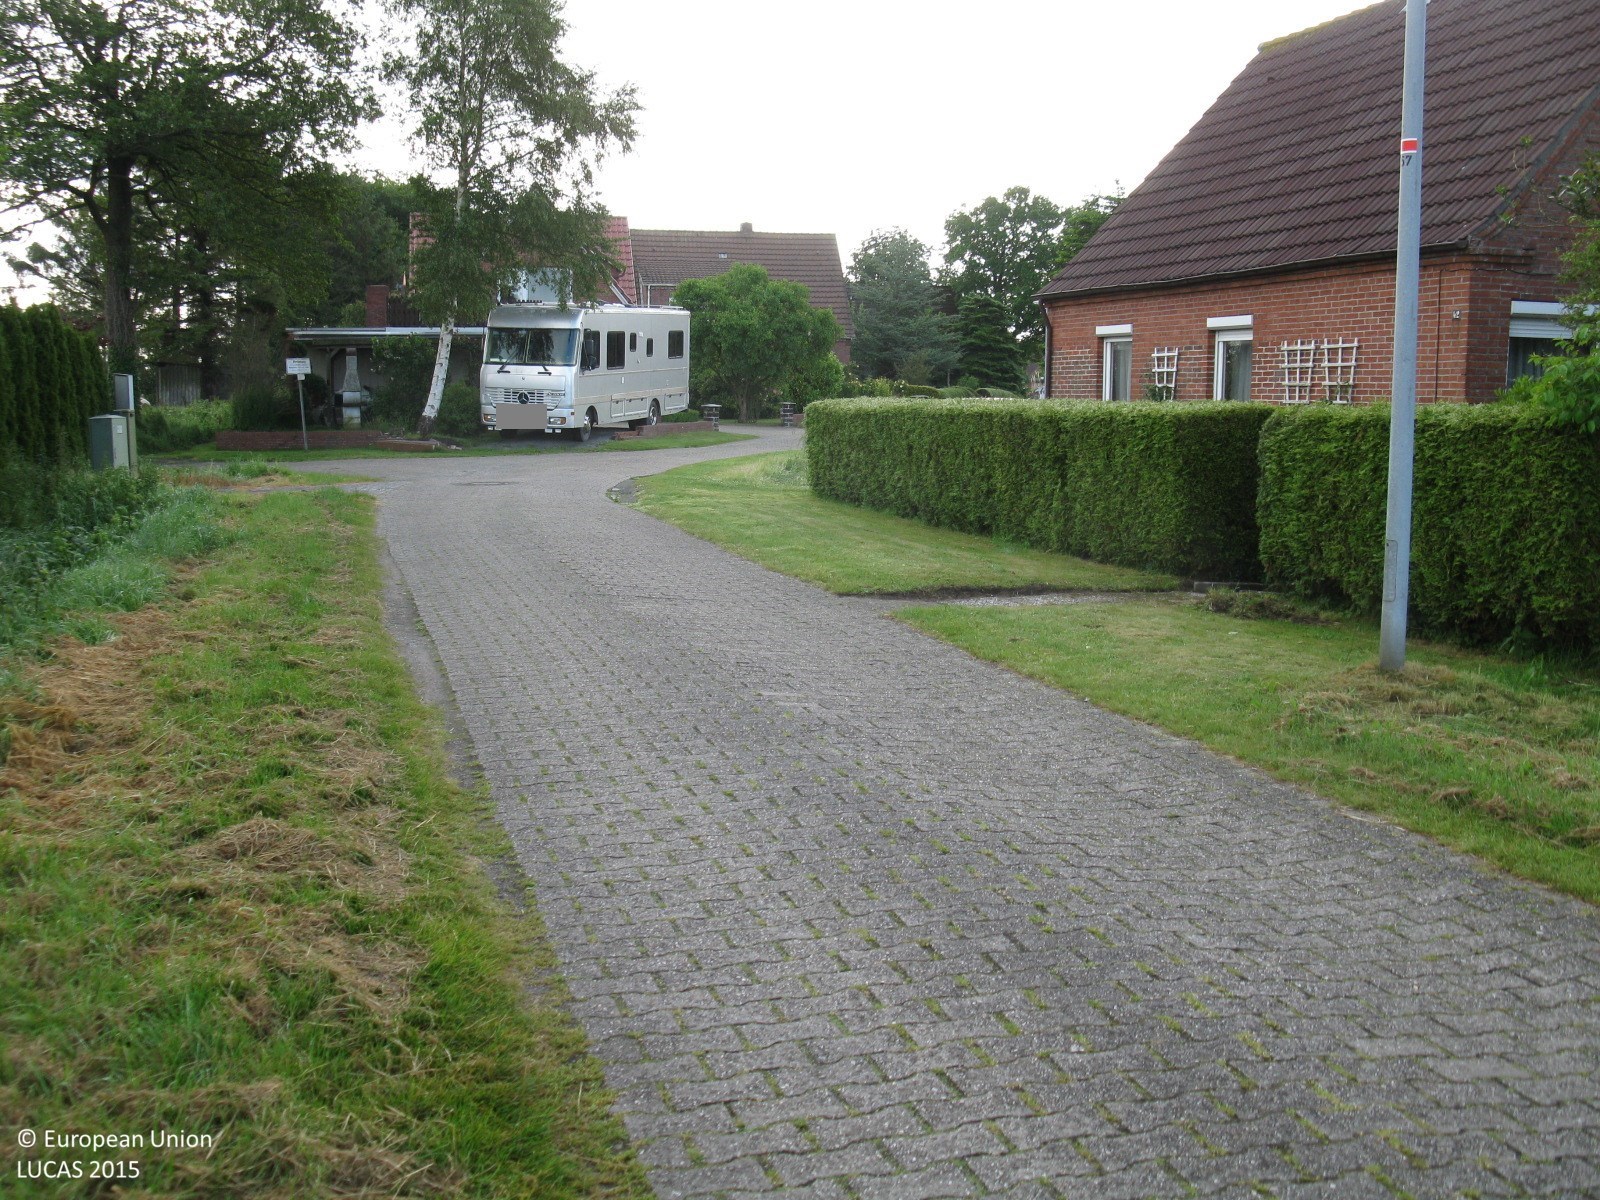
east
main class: Grassland
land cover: Grassland without tree/shrub cover
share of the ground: > 75 %
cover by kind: herbaceous plants 100 %
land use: Agriculture (excluding fallow land and kitchen gardens)
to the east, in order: Grass margins; Artificial constructions in urban areas; Shrubland without tree cover; Ditches and canals; Fences; Spontaneously vegetated surfaces; Grassland without tree/shrub cover
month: June
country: DE
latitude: 53.5337
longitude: 7.3000
